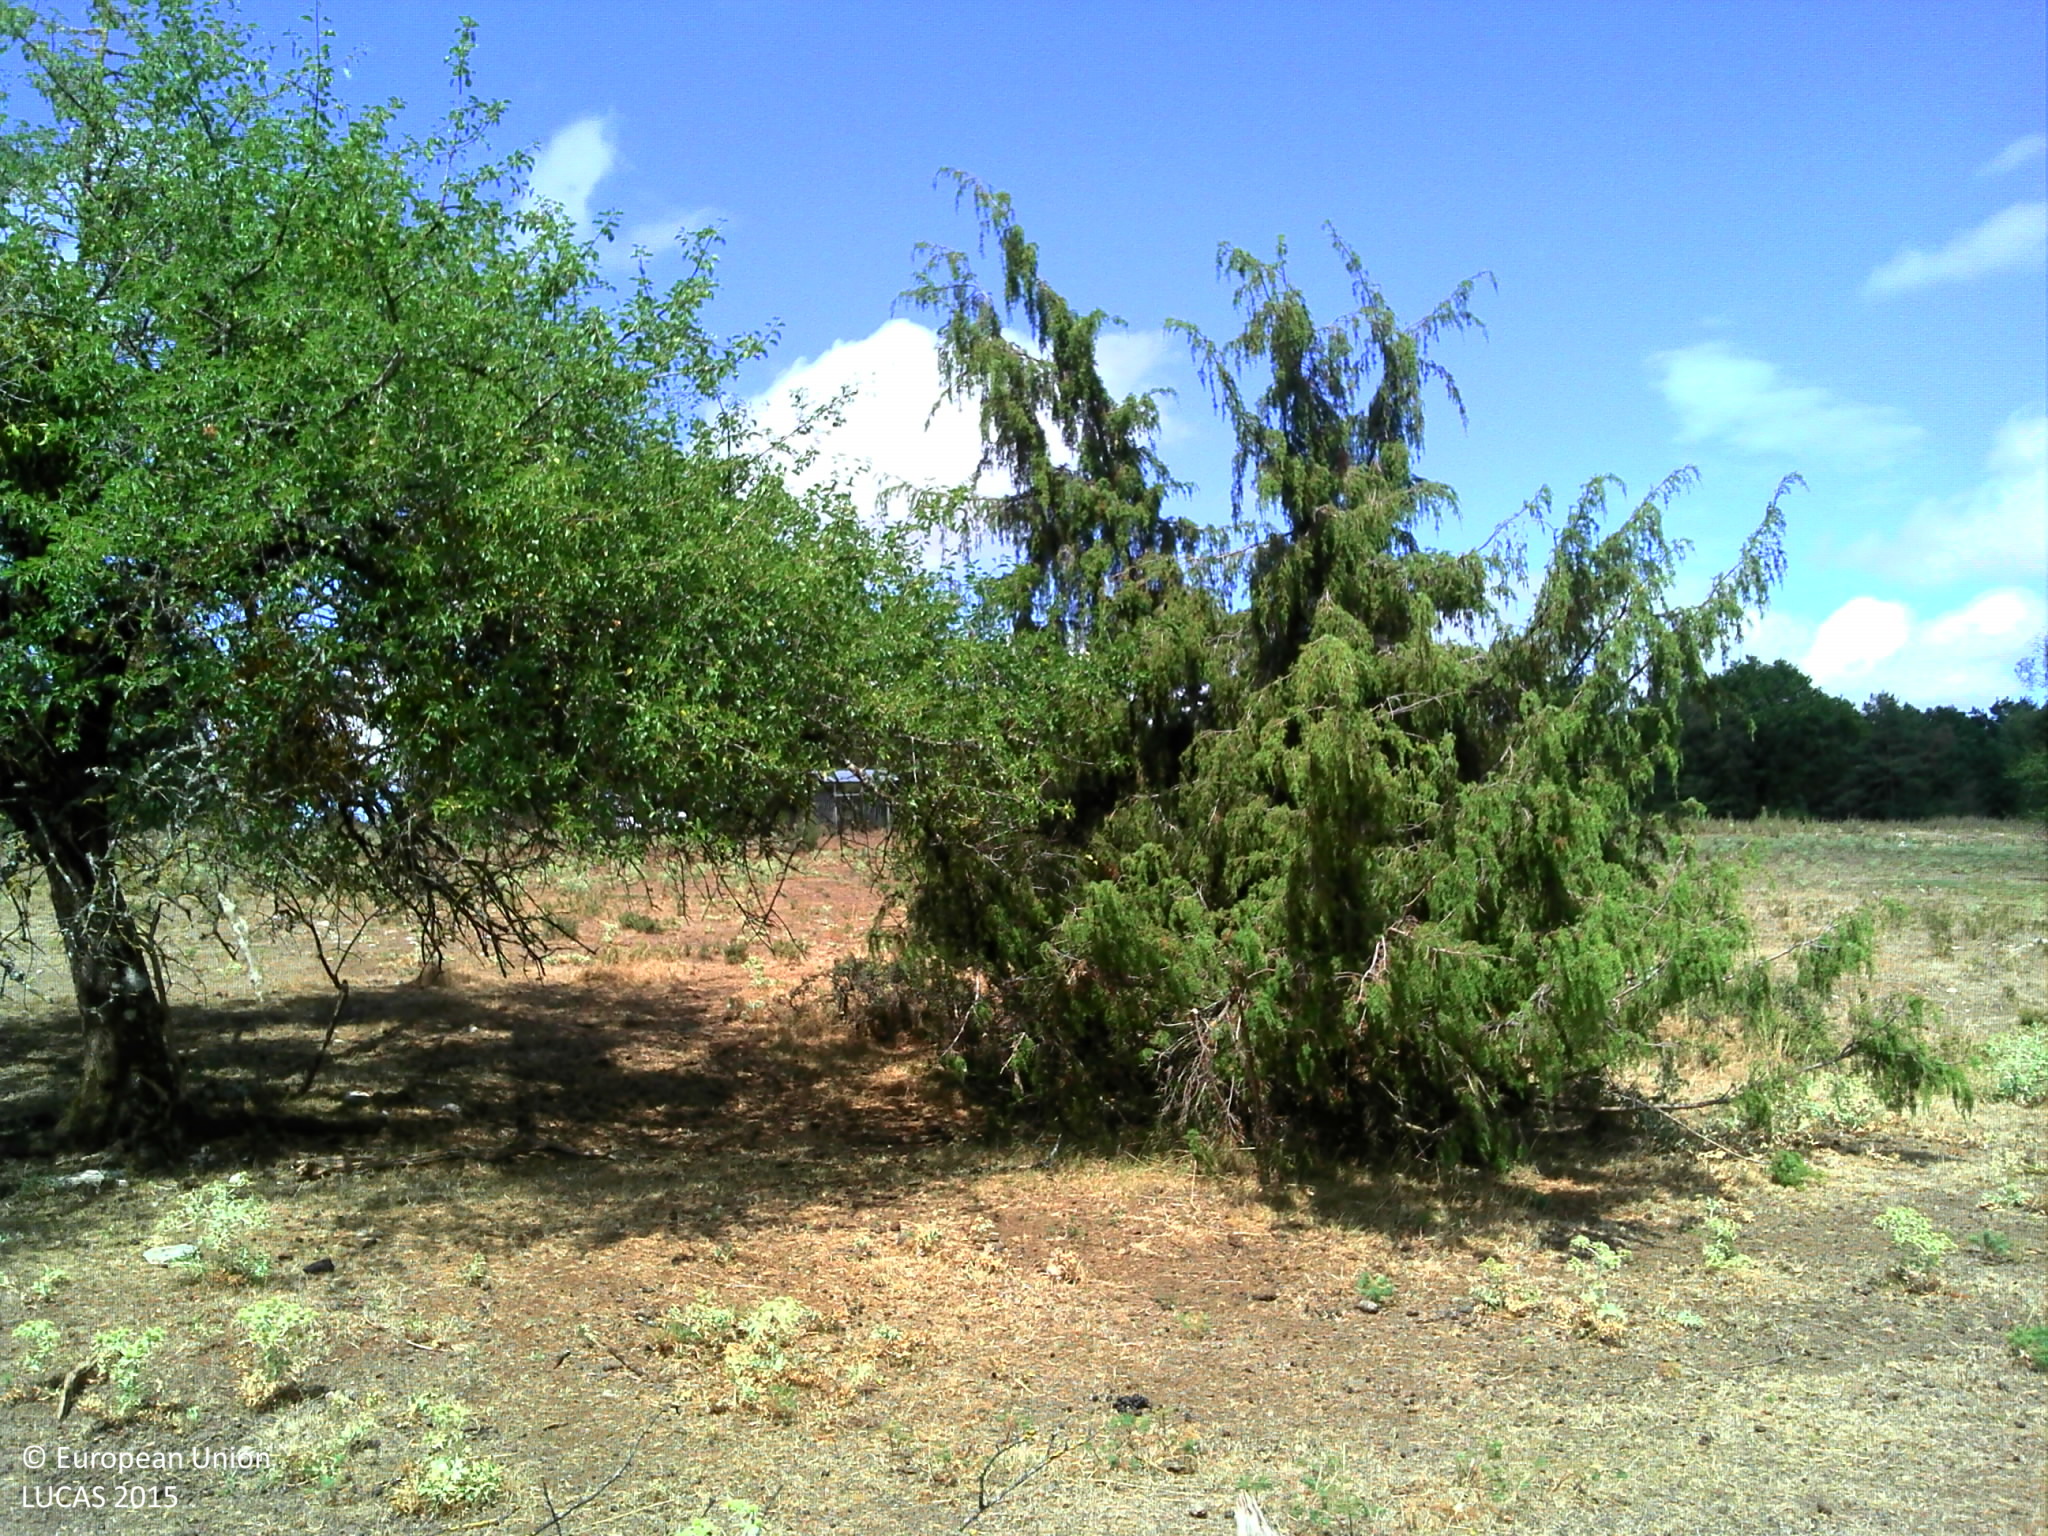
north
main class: Grassland
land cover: Grassland with sparse tree/shrub cover
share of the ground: > 75 %
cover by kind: herbaceous plants 85 %, shrubs 10 %, broadleaved forest trees 5 %
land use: Agriculture (excluding fallow land and kitchen gardens)
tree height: > 5 m
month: July
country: FR
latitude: 47.7131
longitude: 5.4018
